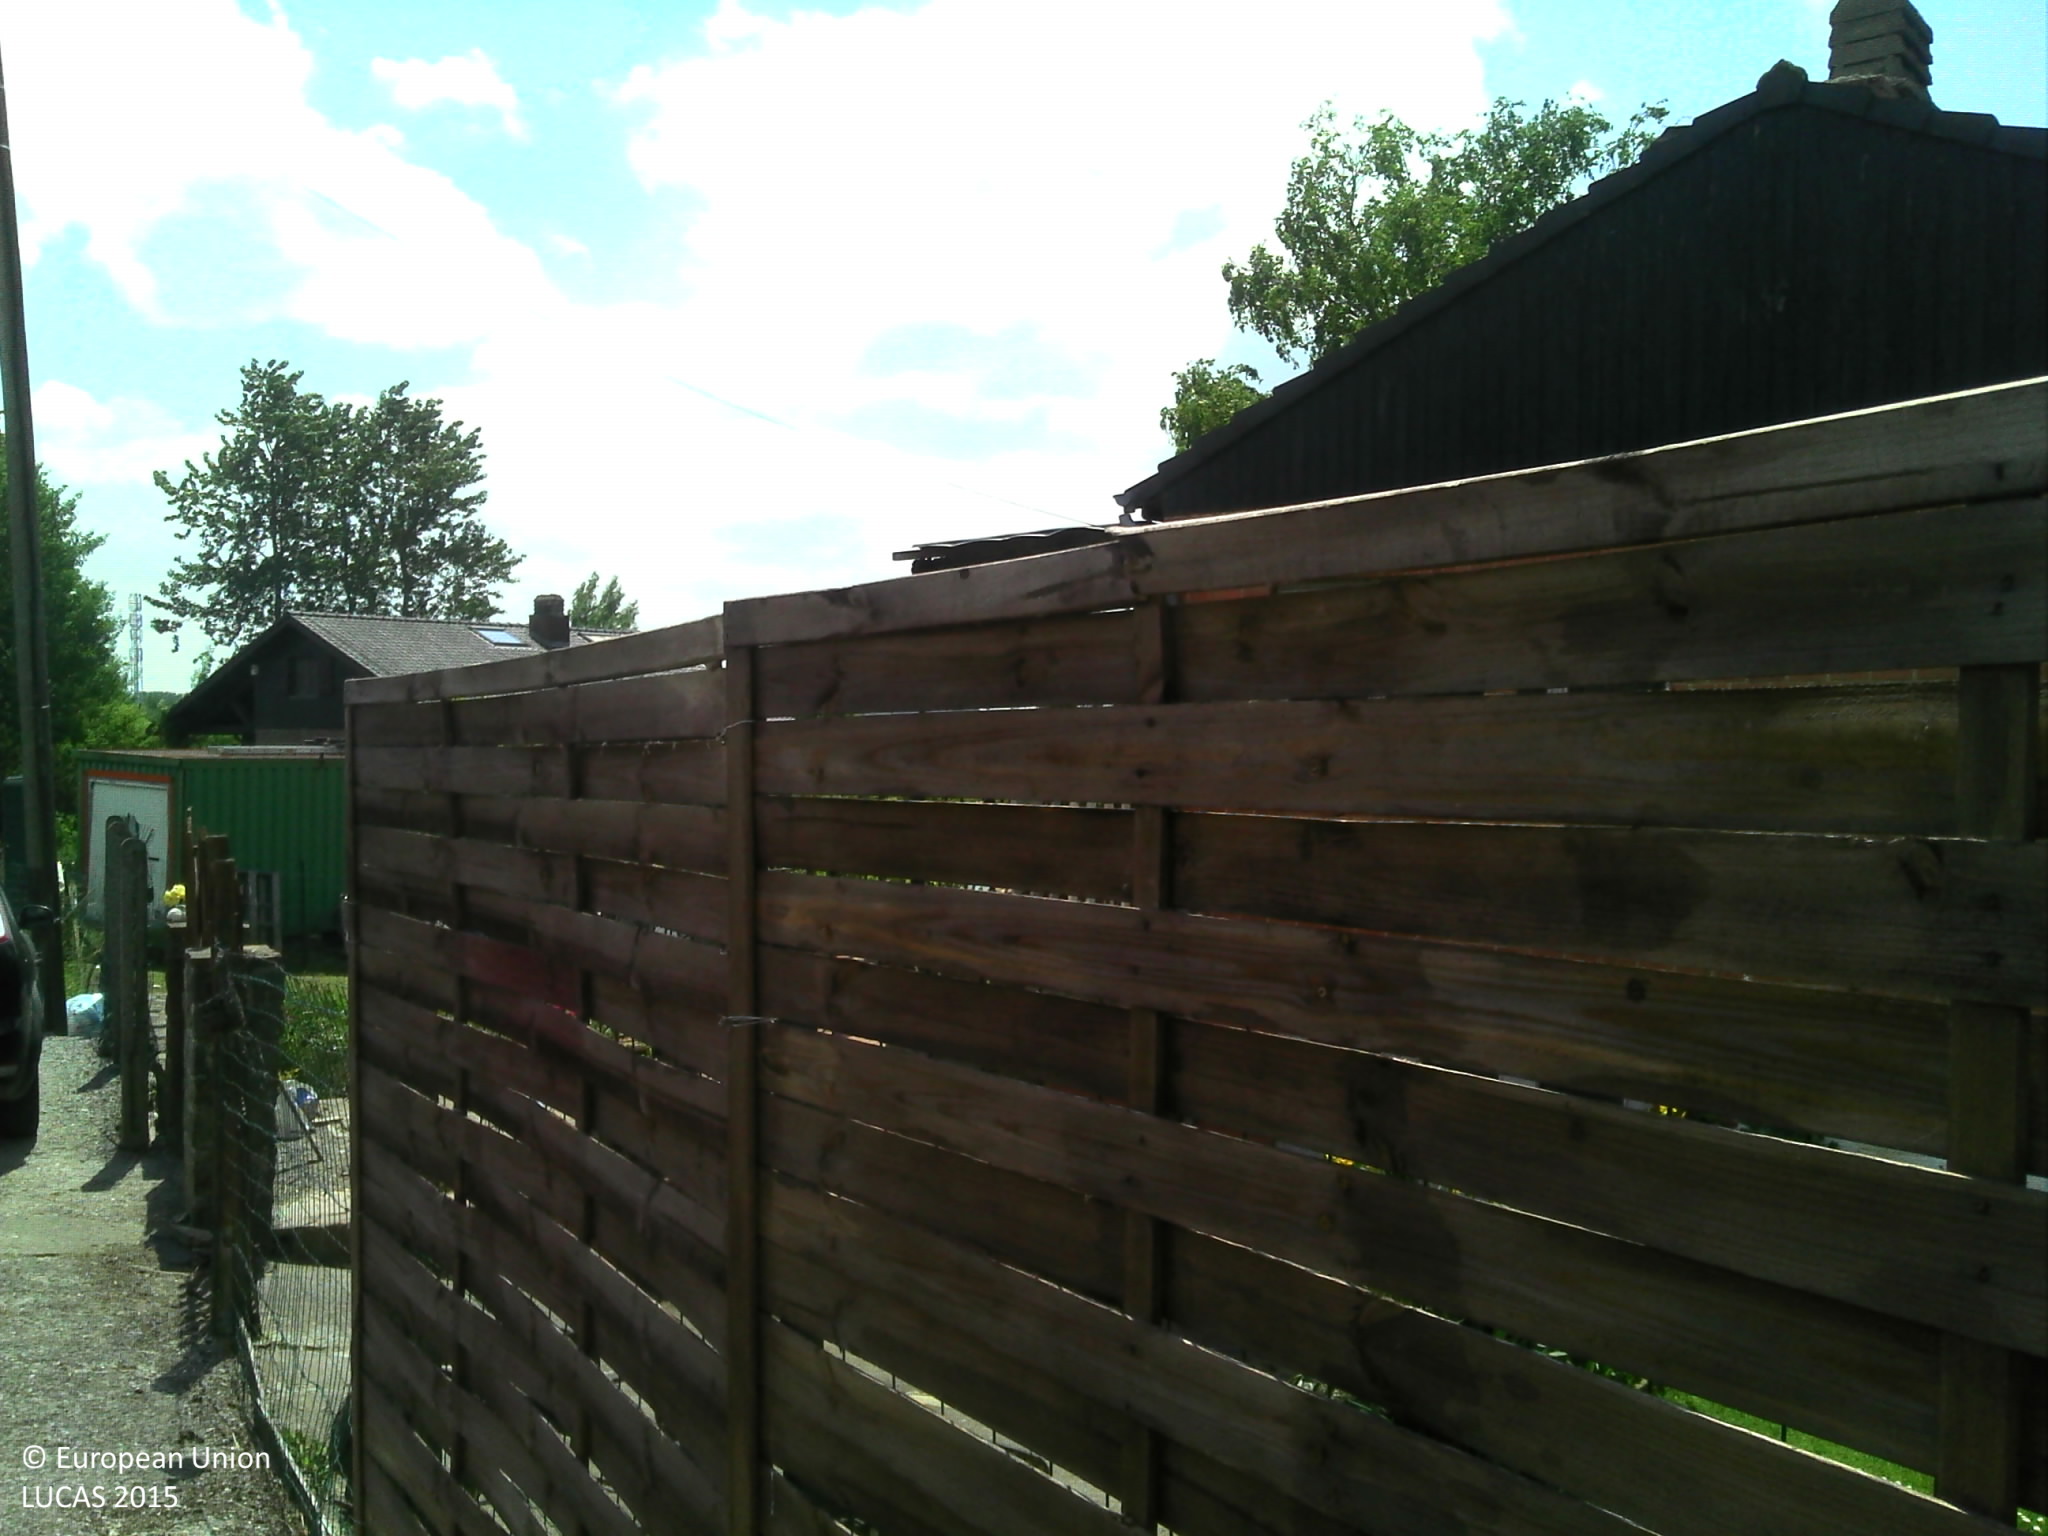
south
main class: Grassland
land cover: Grassland without tree/shrub cover
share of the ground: > 75 %
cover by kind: herbaceous plants 100 %
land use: Residential
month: June
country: BE
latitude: 50.3454
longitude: 4.6142
